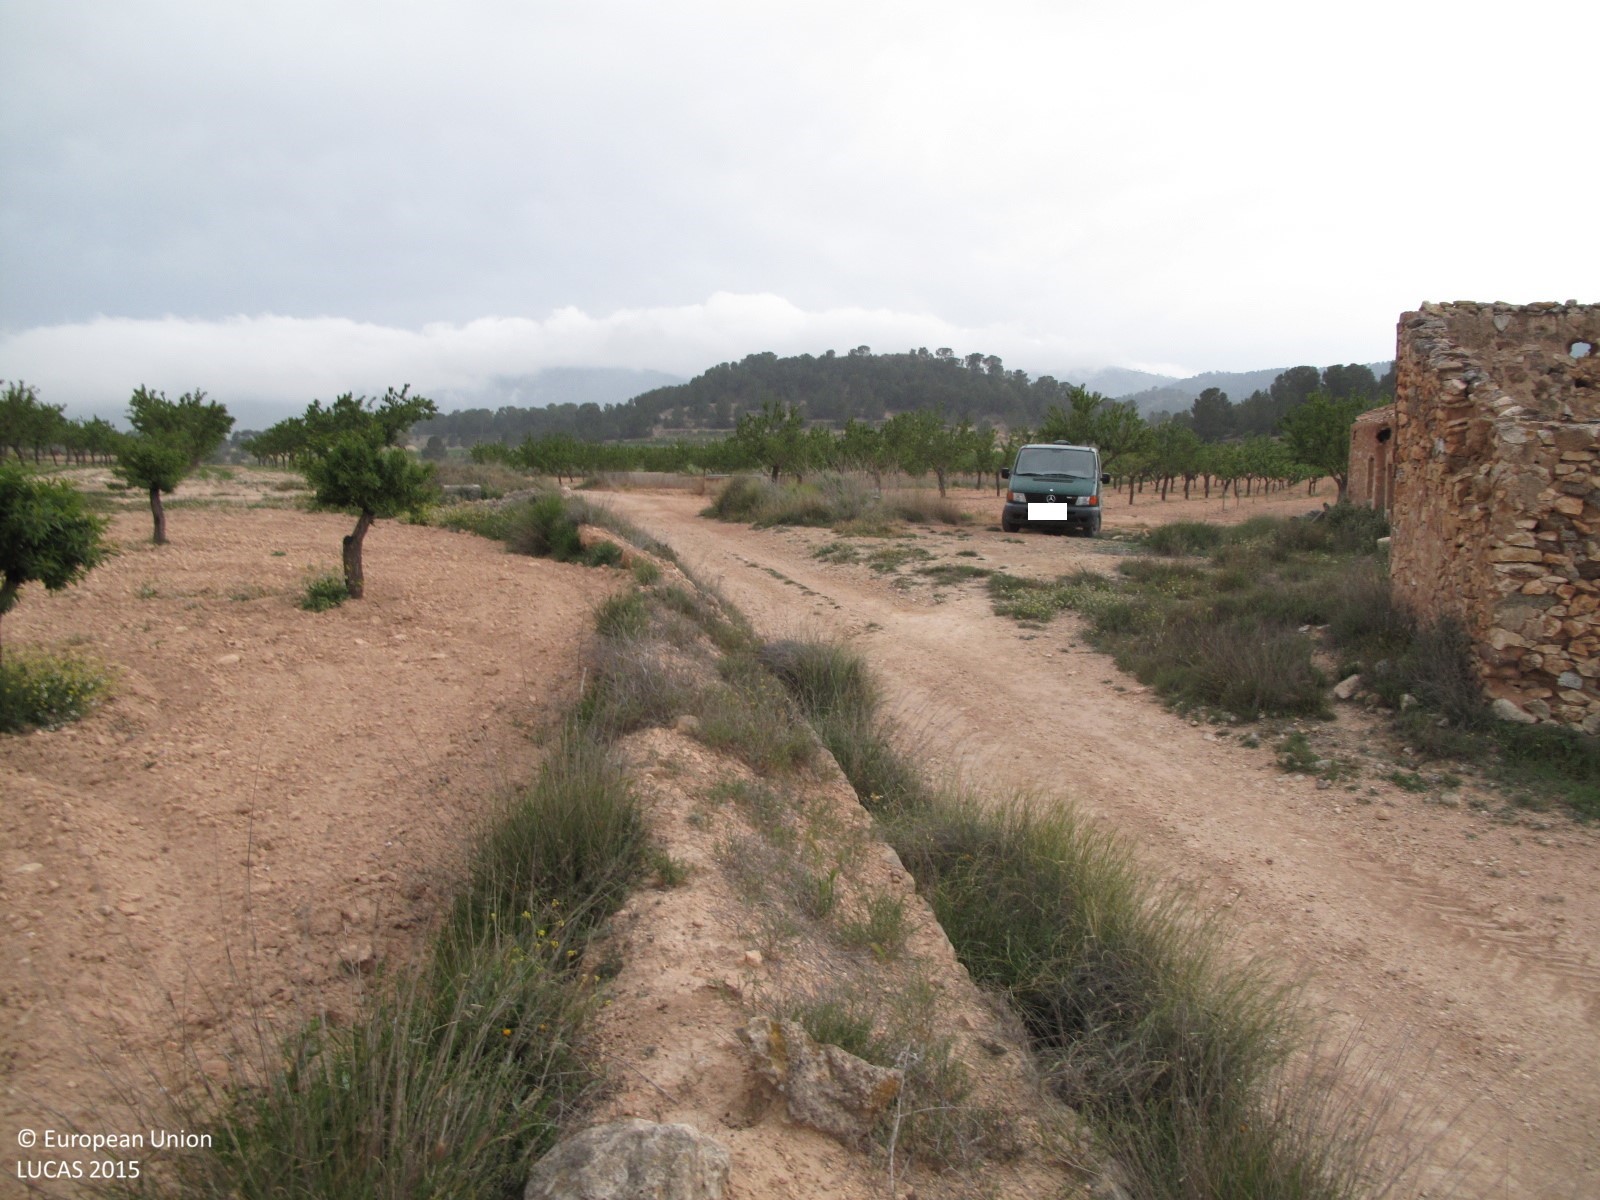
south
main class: Cropland
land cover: Nuts trees
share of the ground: < 10 %
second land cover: Other bare soil
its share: > 75 %
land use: Agriculture (excluding fallow land and kitchen gardens)
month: April
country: ES
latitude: 38.4266
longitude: -0.9735
